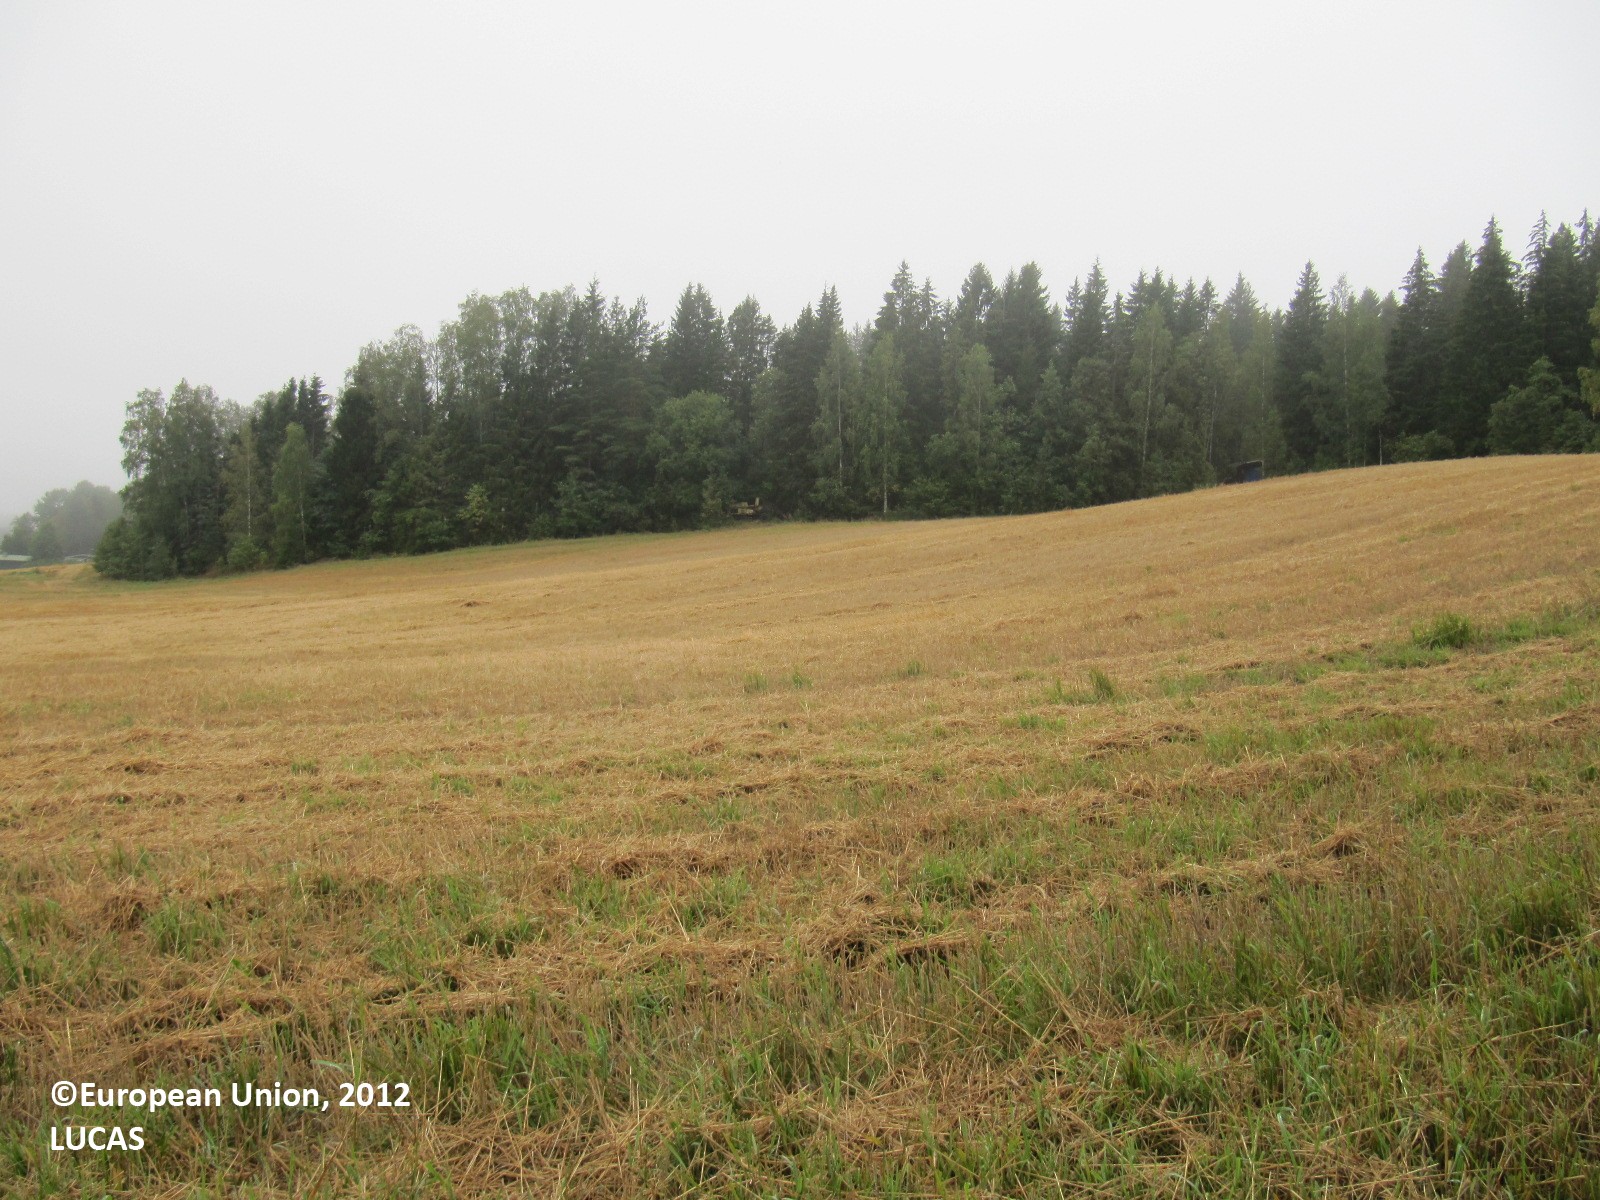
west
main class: Grassland
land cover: Spontaneously vegetated surfaces
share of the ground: > 75 %
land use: Agriculture (excluding fallow land and kitchen gardens)
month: August
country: FI
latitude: 60.1986
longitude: 24.3005
